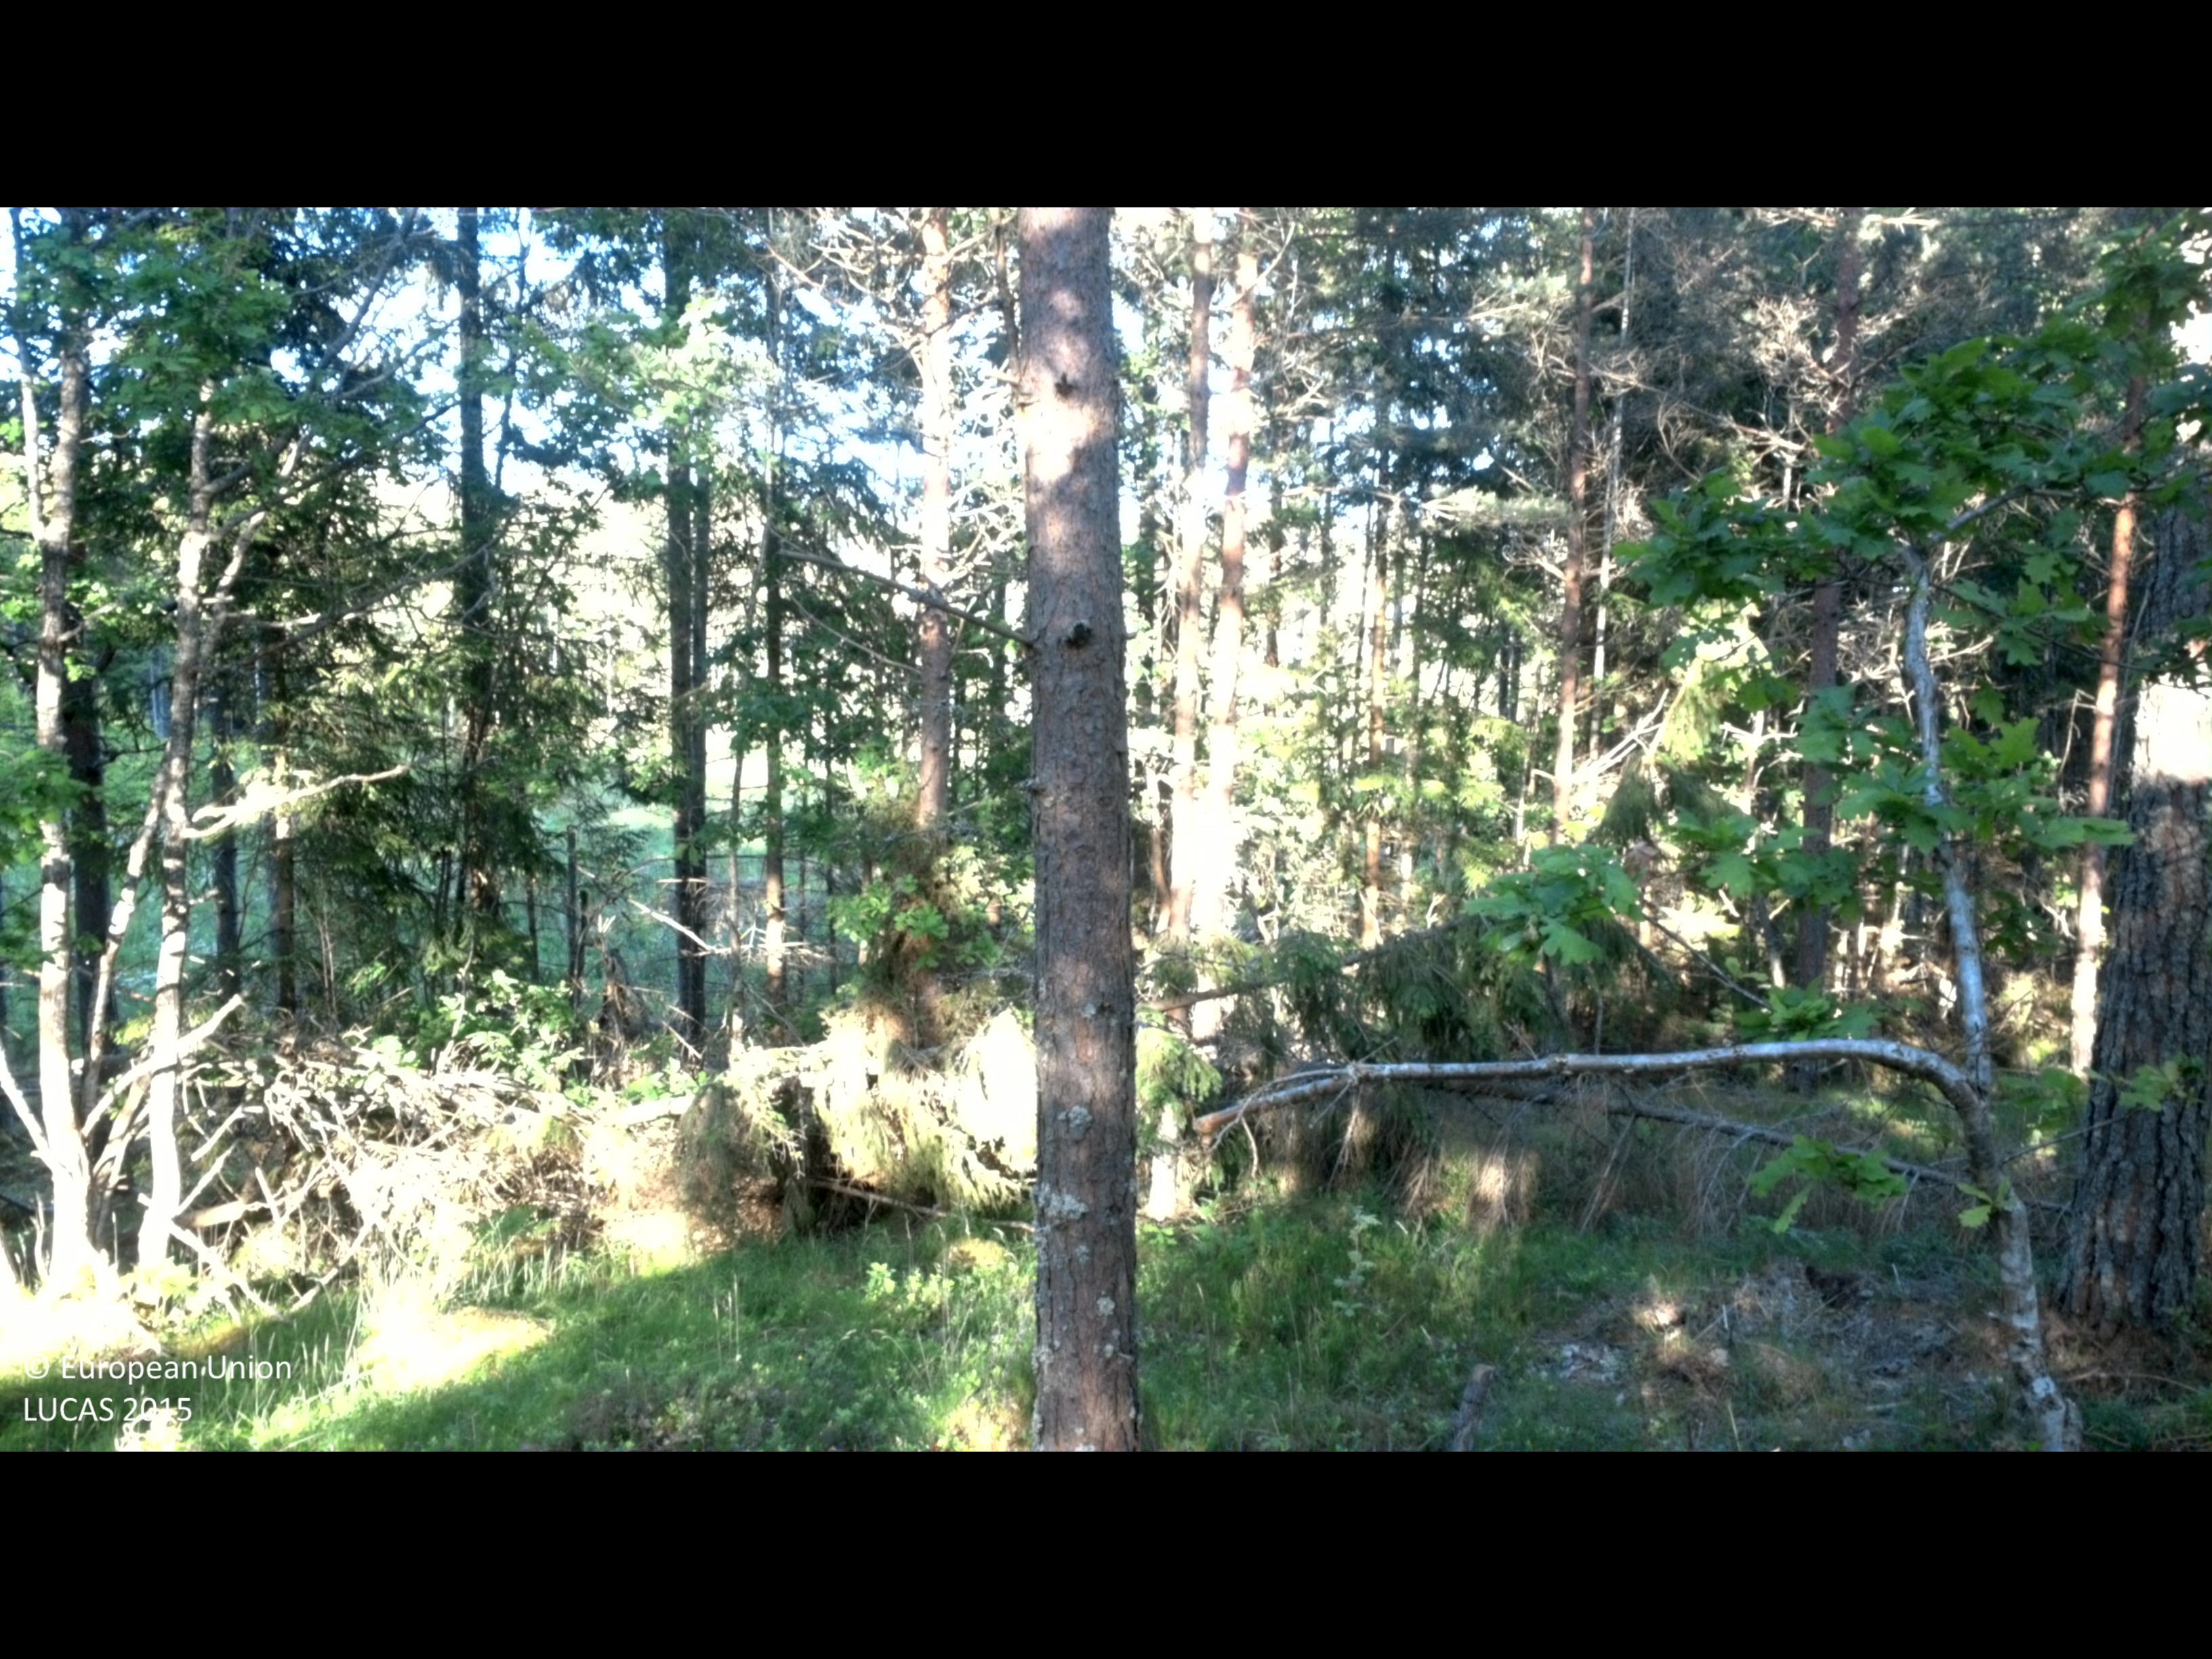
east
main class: Woodland
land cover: Pine dominated coniferous woodland
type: boreal forest
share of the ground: 50 - 75 %
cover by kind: coniferous forest trees 60 %, broadleaved forest trees 15 %, shrubs 15 %, herbaceous plants 5 %, lichens and mosses 5 %
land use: Forestry
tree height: > 5 m
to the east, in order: Pine dominated coniferous woodland; Ditches and canals; Spruce dominated coniferous woodland; Spruce dominated mixed woodland; Ditches and canals; Groves; Pine dominated mixed woodland; Tracks; Electric lines; Pine dominated coniferous woodland; Ditches and canals; Broadleaved woodland; Paved roads, cycling and walking lanes; Ditches and canals; Broadleaved woodland
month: June
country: SE
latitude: 57.8073
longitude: 16.5449
